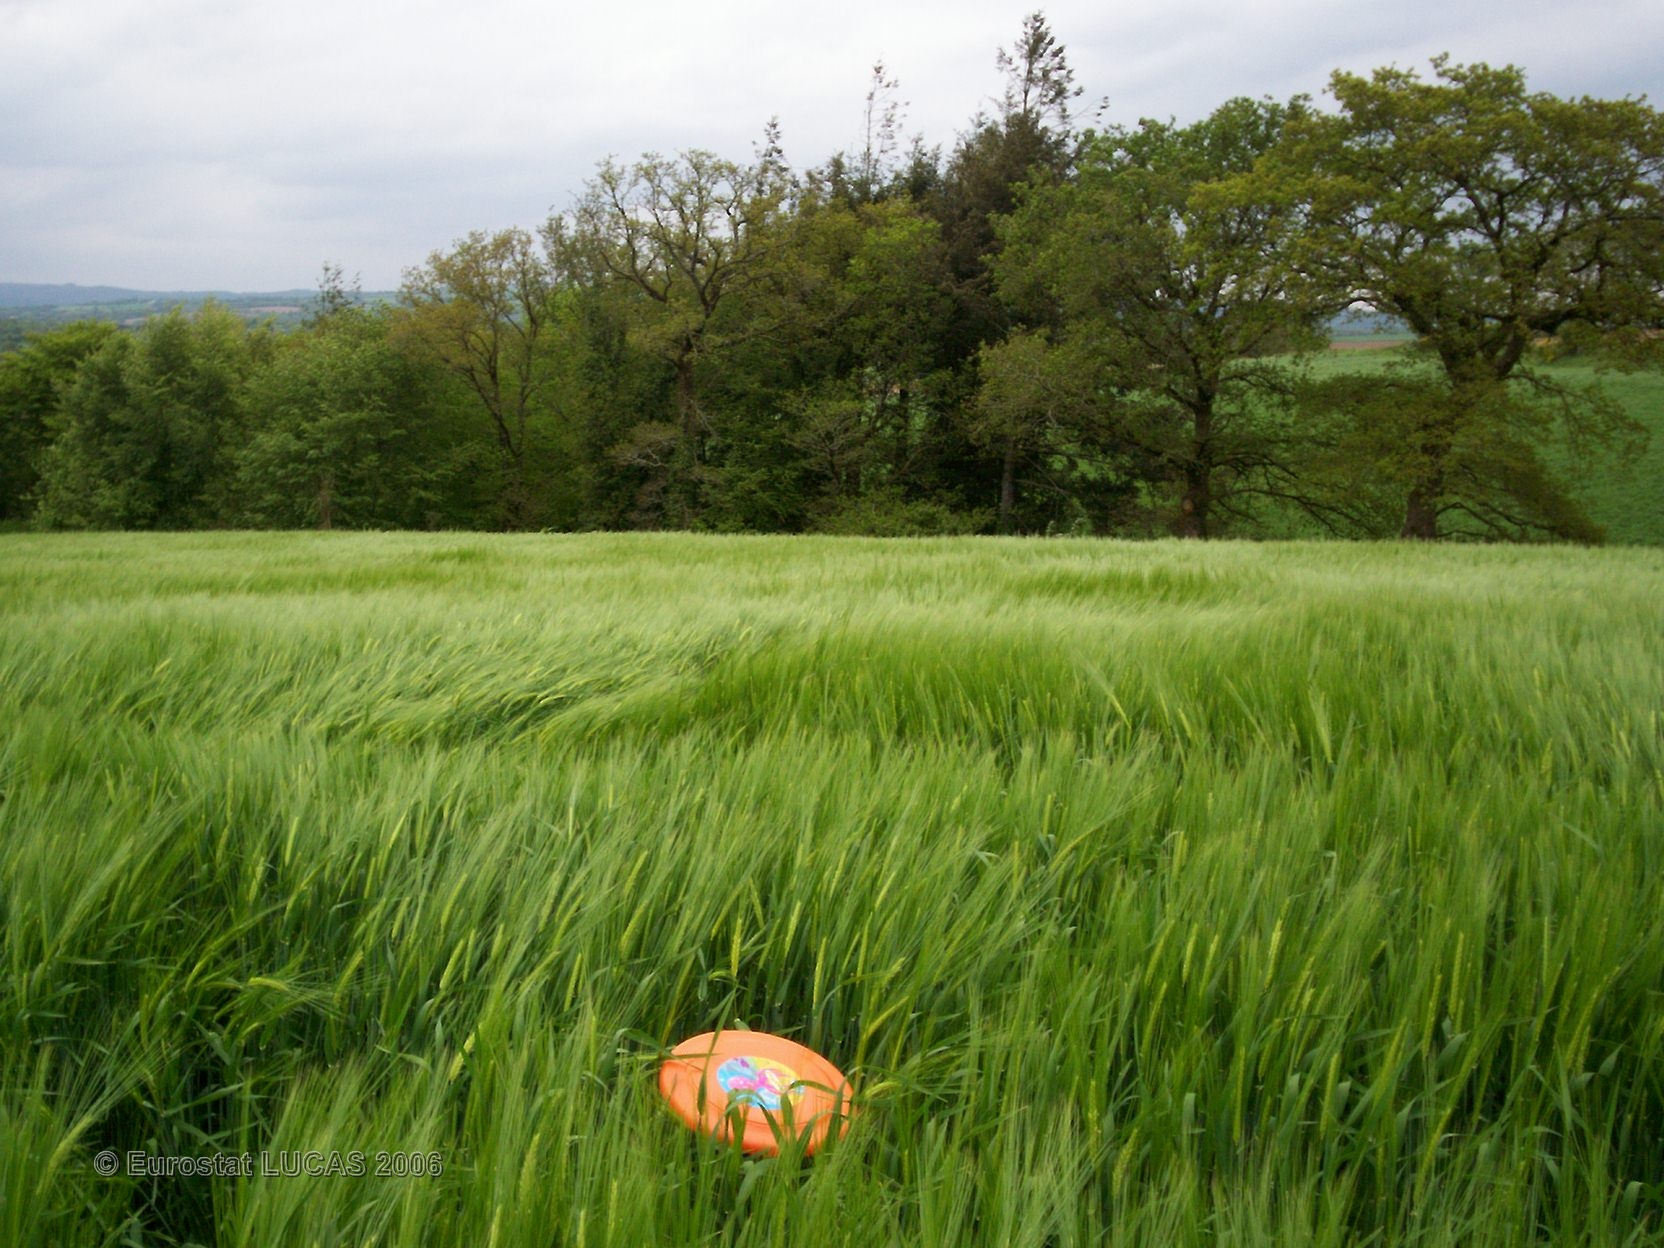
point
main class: Cropland
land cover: Barley
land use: Agriculture (excluding fallow land and kitchen gardens)
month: May
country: FR
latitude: 48.2927
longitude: -3.7092
